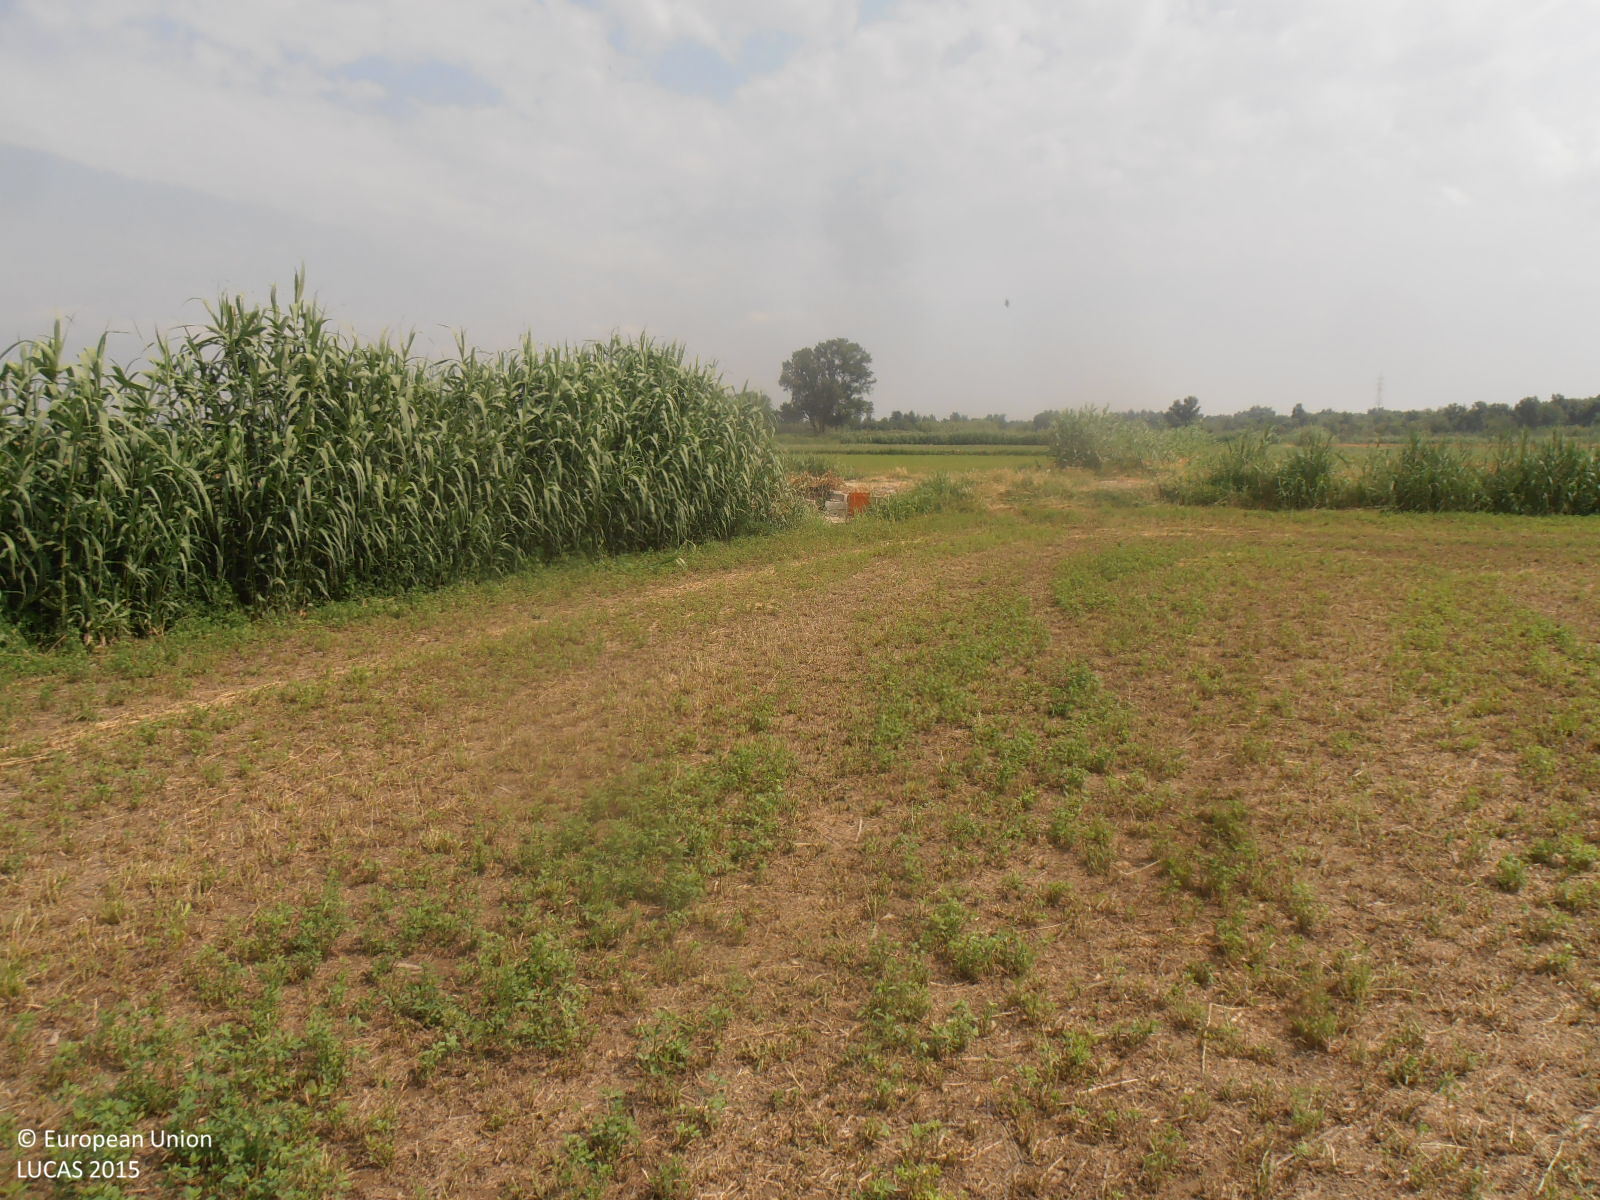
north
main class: Cropland
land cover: Lucerne
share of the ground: > 75 %
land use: Agriculture (excluding fallow land and kitchen gardens)
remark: Harvested field
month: June
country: ES
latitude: 41.7462
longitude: -0.8086
